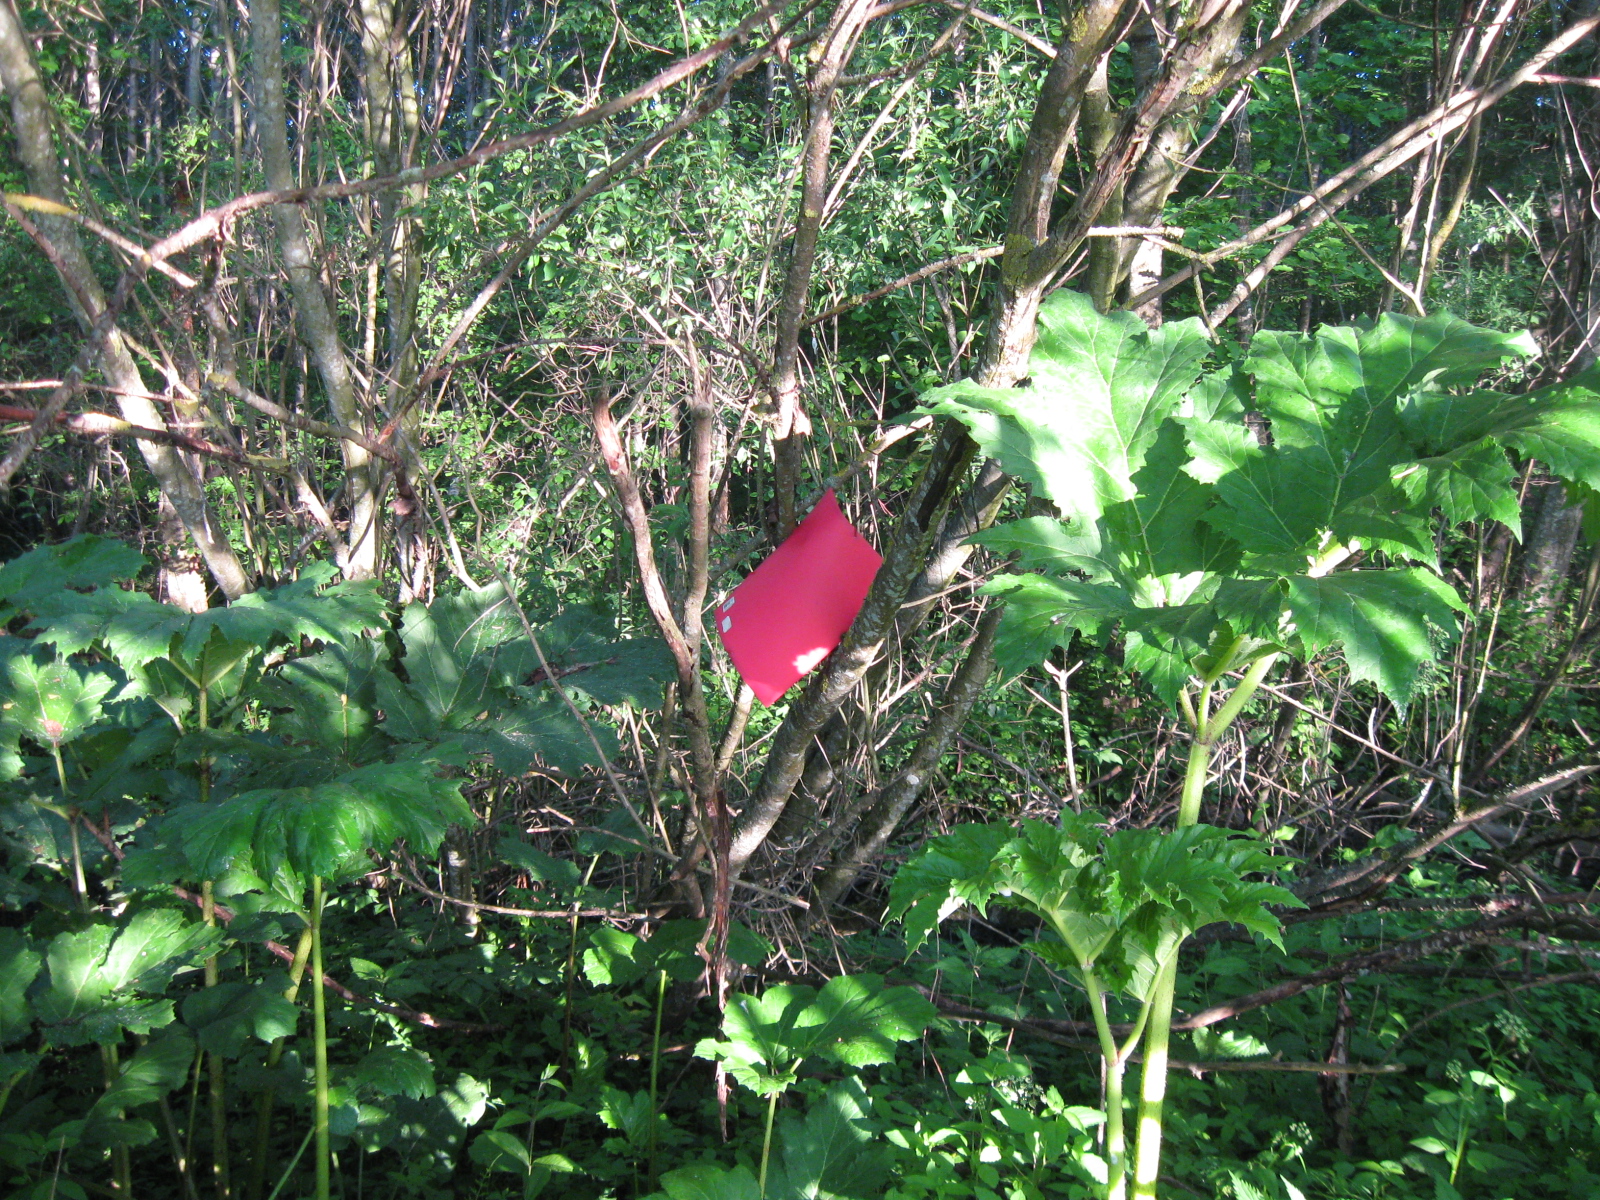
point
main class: Woodland
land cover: Broadleaved woodland
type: non-riverine alder, birch or aspen forest
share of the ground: > 75 %
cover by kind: broadleaved forest trees 90 %, herbaceous plants 10 %
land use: Forestry
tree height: > 5 m
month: June
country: LT
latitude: 55.0664
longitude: 24.0116
